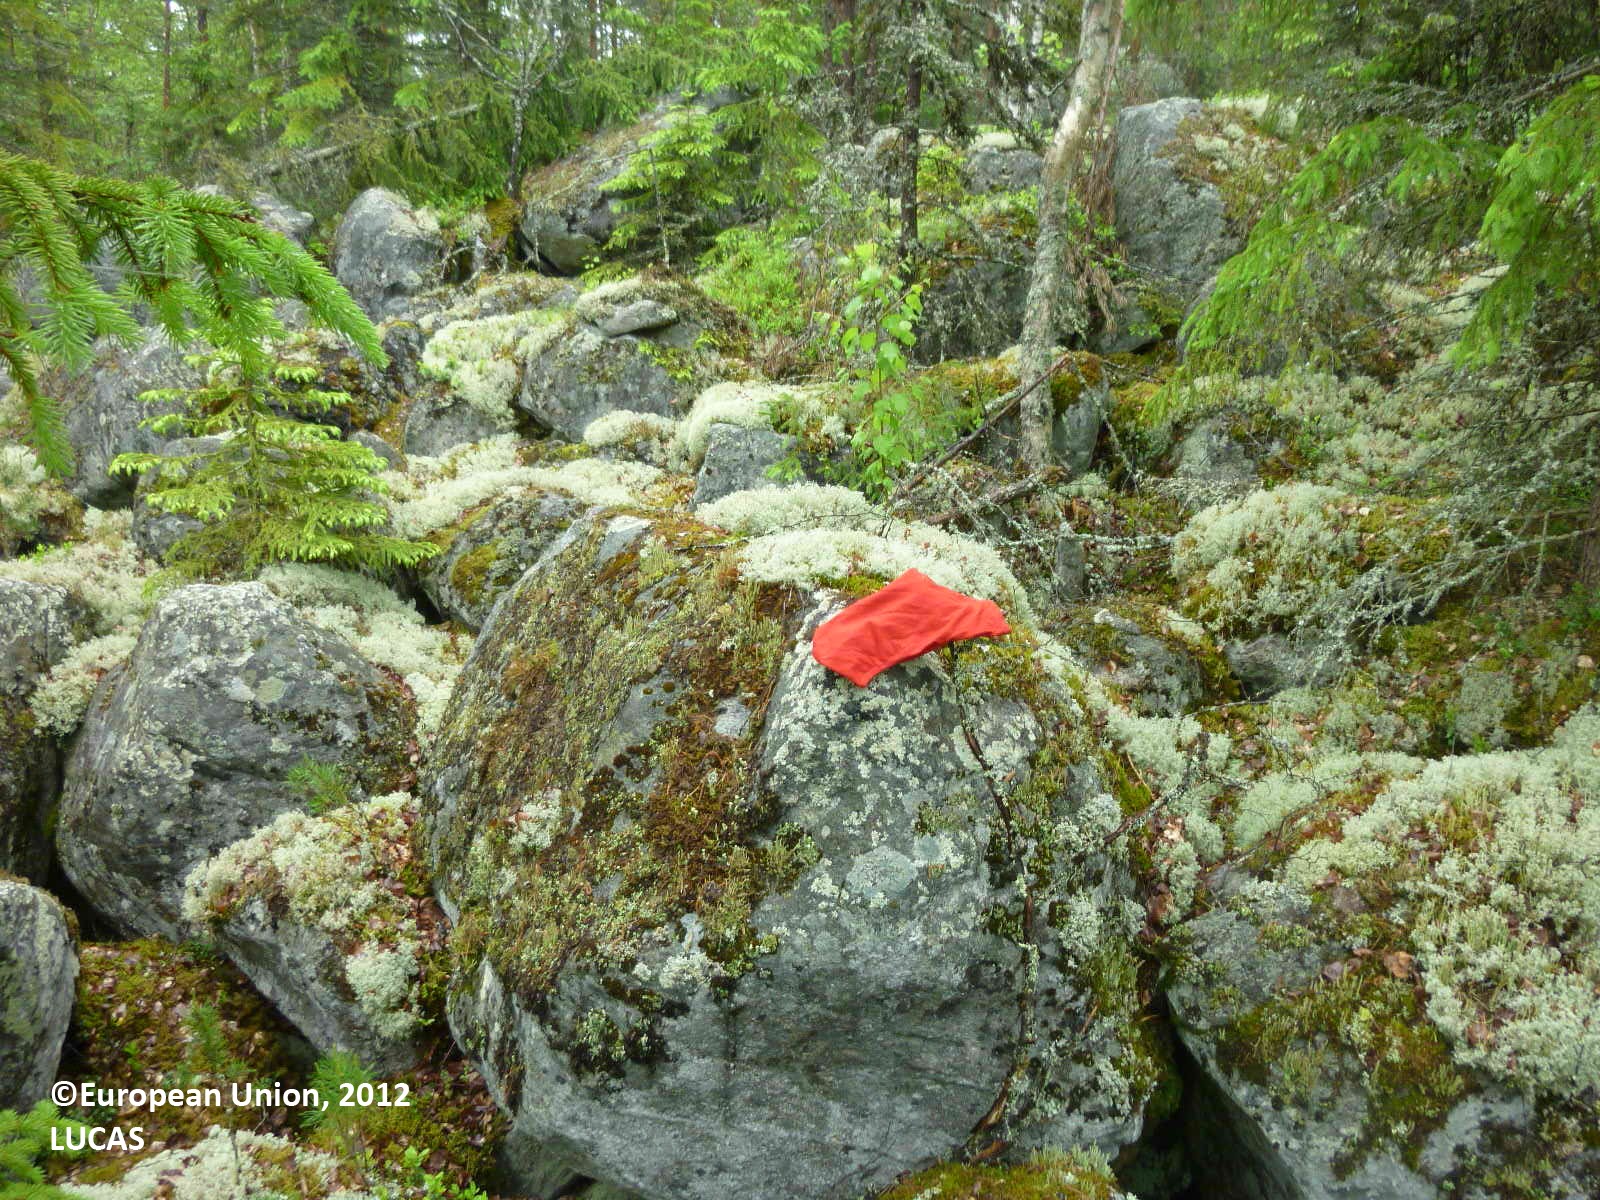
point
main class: Woodland
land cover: Spruce dominated mixed woodland
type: boreal forest
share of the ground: 25 - 50 %
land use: Forestry
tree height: > 5 m
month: June
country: FI
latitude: 61.5803
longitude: 22.2457
